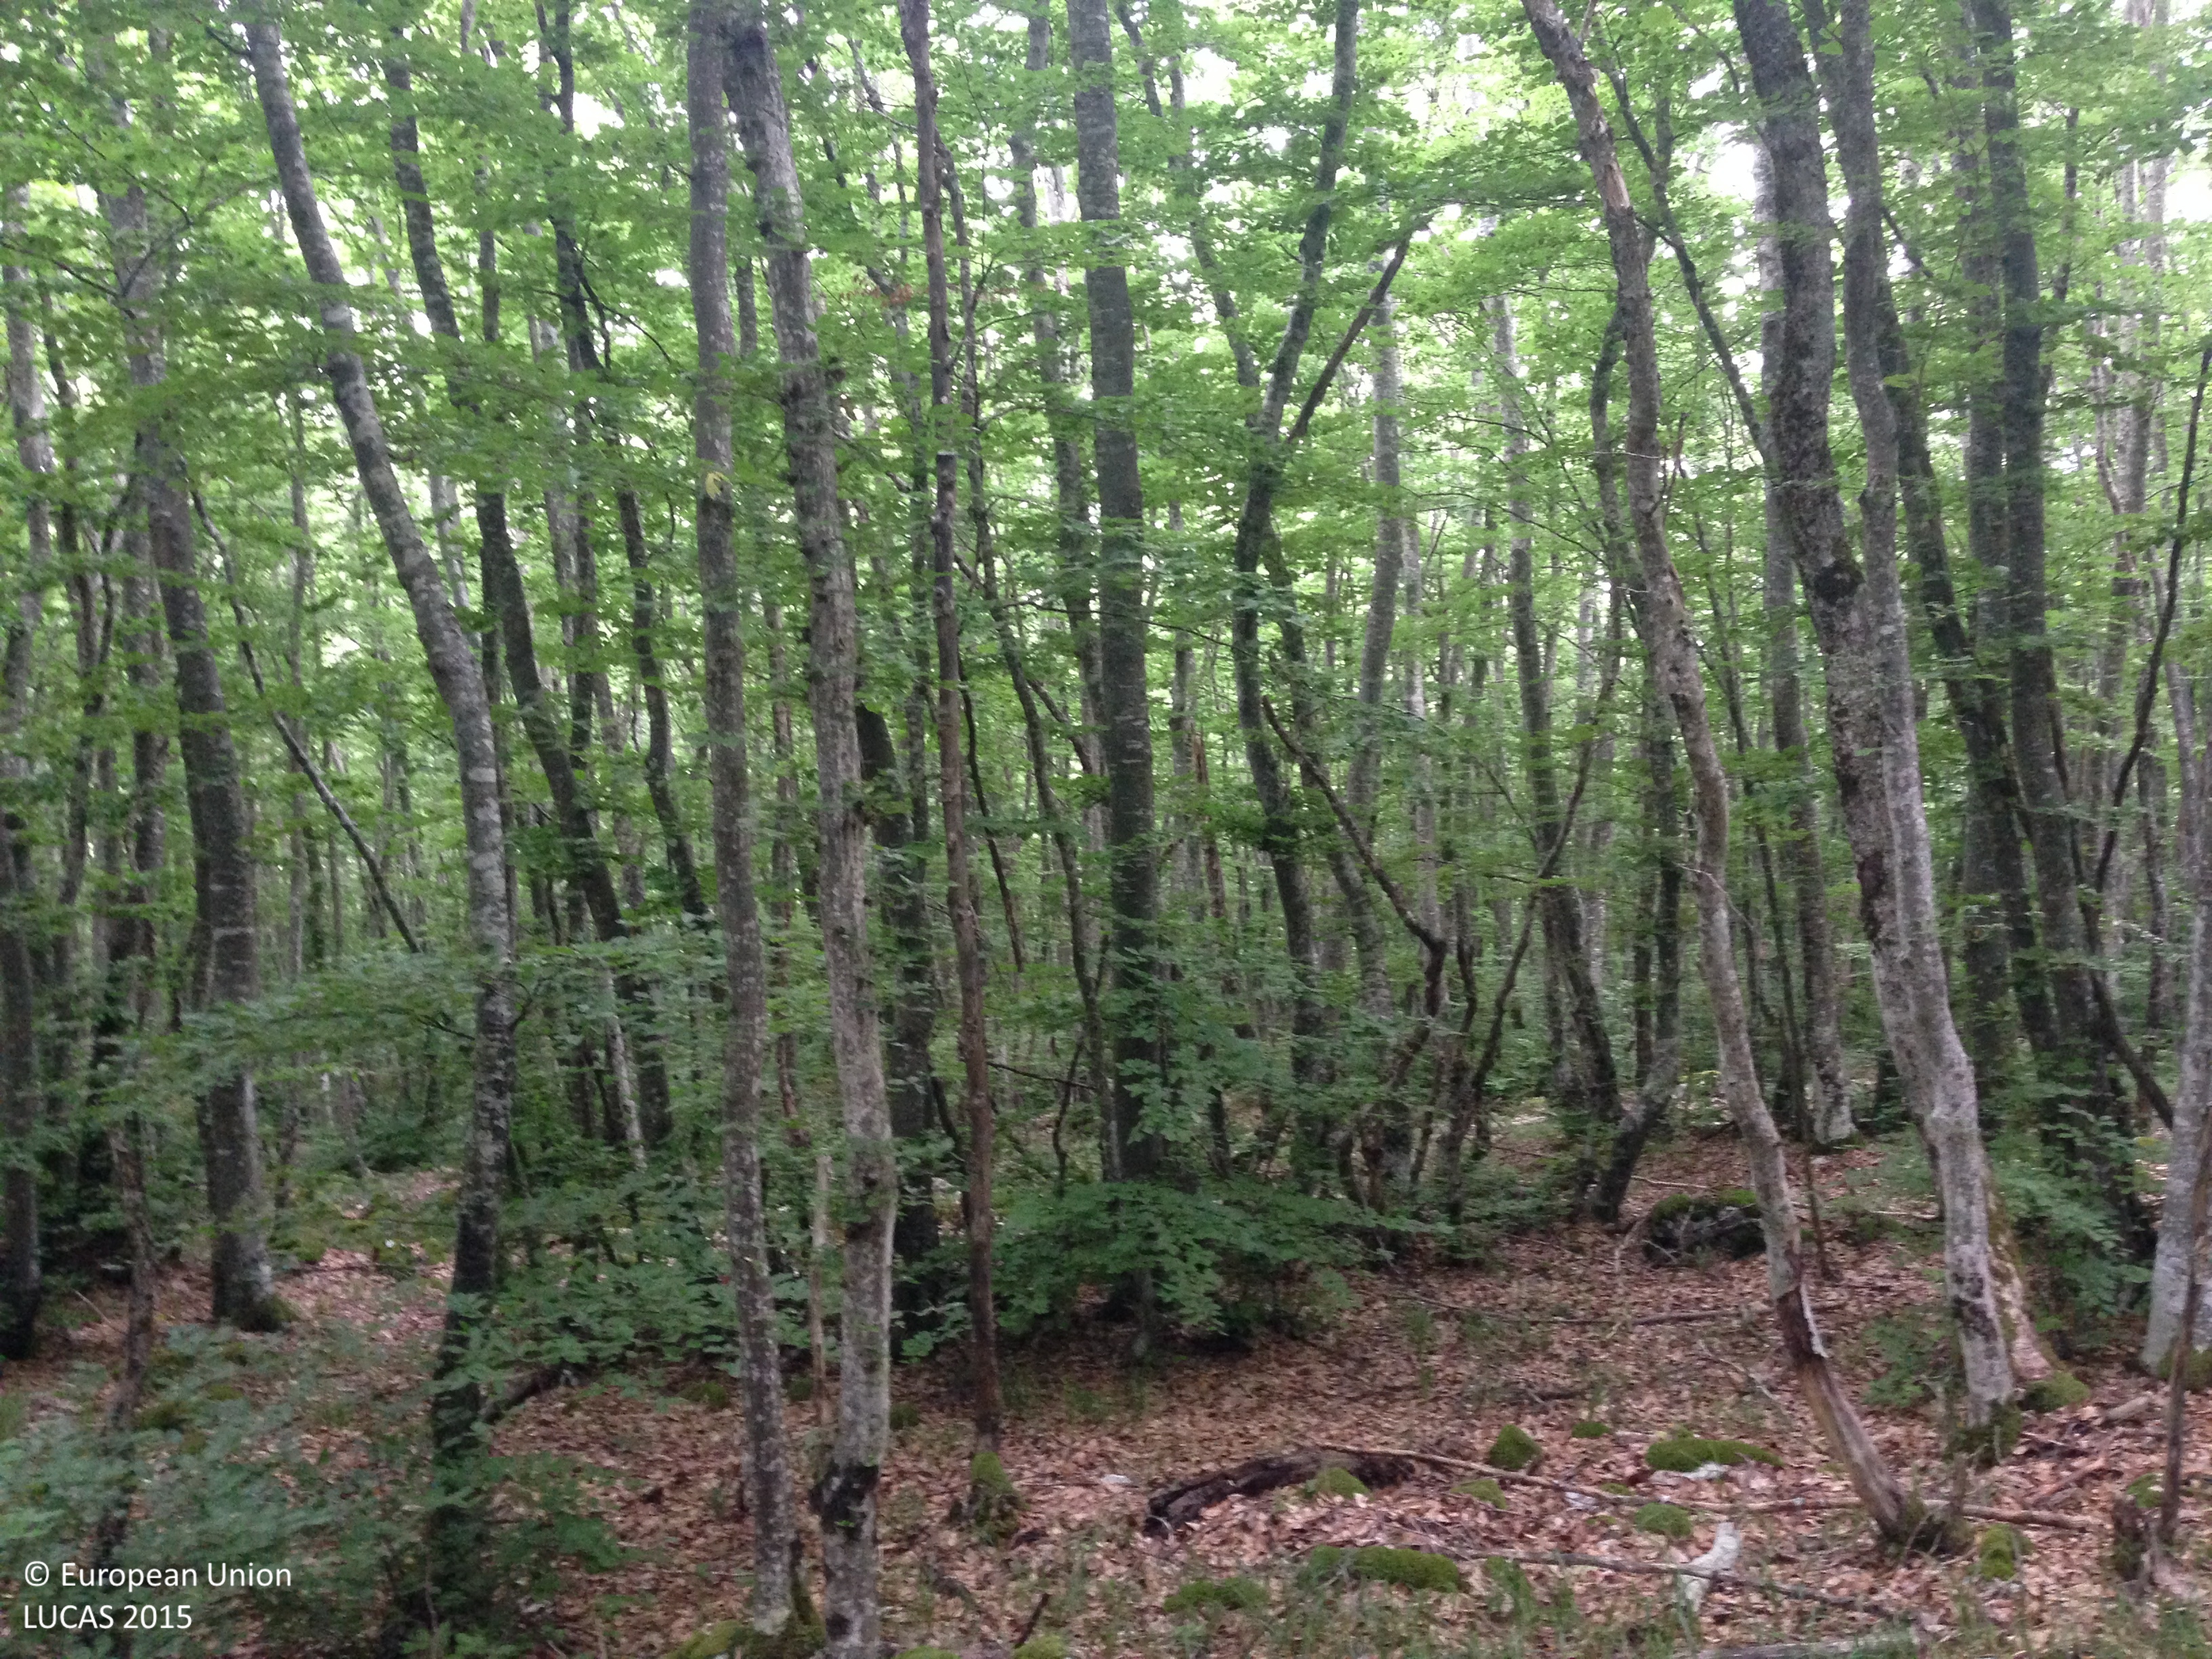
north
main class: Woodland
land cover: Broadleaved woodland
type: mountainous beech forest
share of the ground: > 75 %
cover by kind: broadleaved forest trees 80 %, shrubs 10 %, herbaceous plants 5 %, consolidated bare surface 5 %
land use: Forestry
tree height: > 5 m
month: June
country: HR
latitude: 44.6994
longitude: 15.7110
